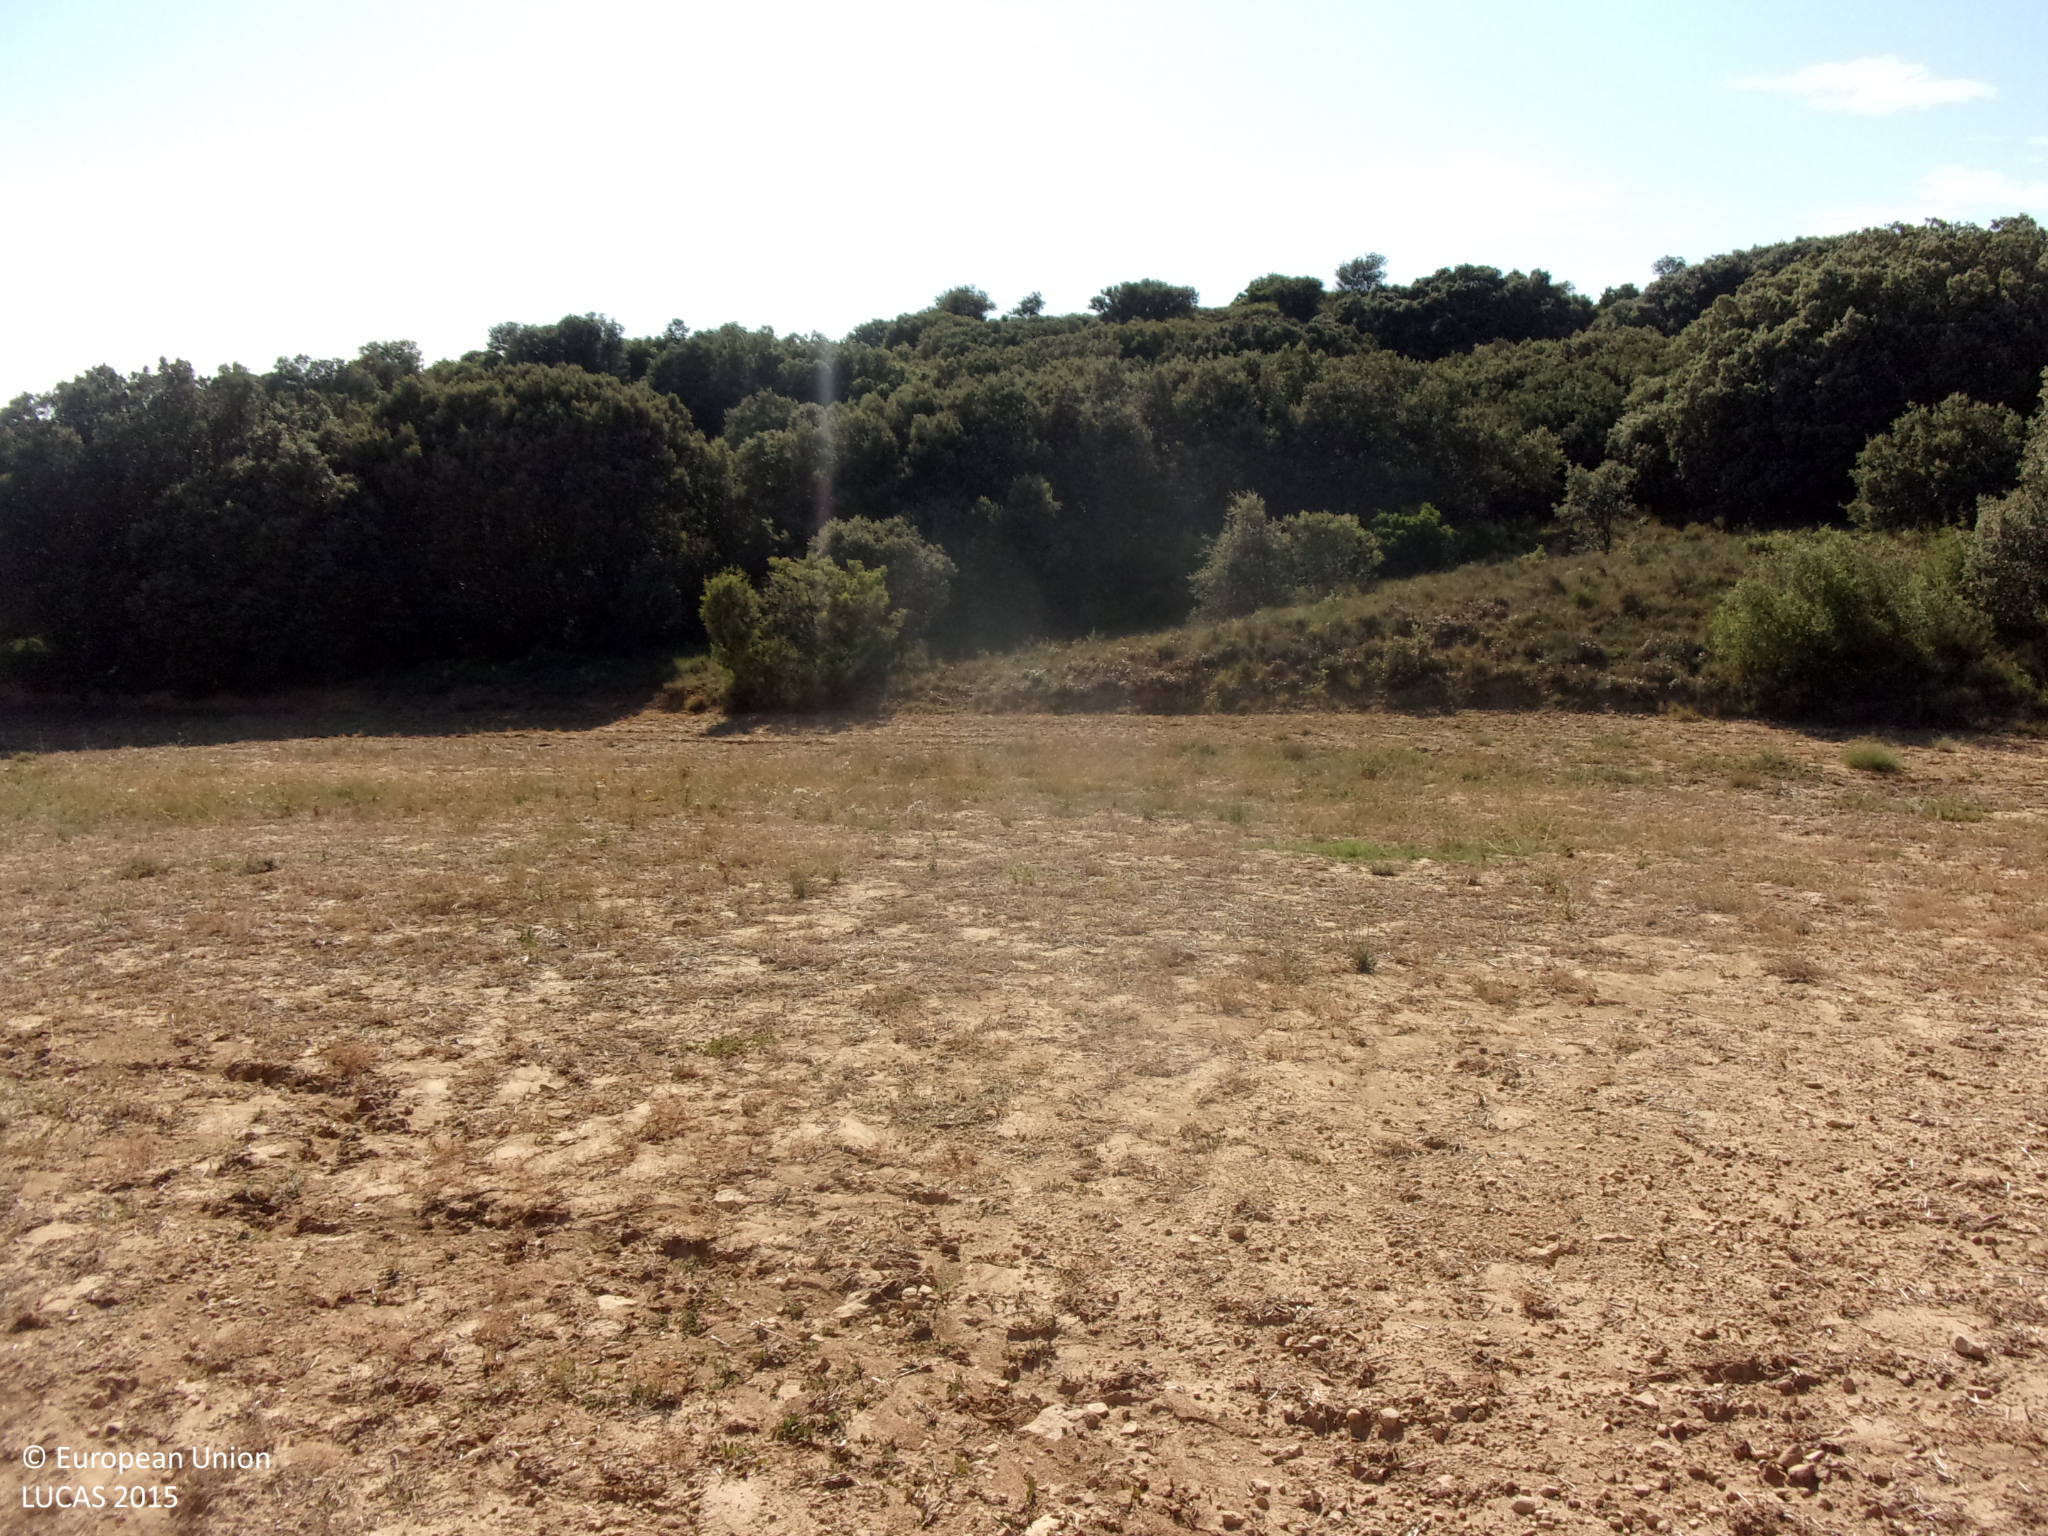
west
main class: Grassland
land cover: Spontaneously vegetated surfaces
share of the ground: 50 - 75 %
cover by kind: herbaceous plants 75 %, unconsolidated bare surface 25 %
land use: Fallow land
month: August
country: ES
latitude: 42.3349
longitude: -1.0861
